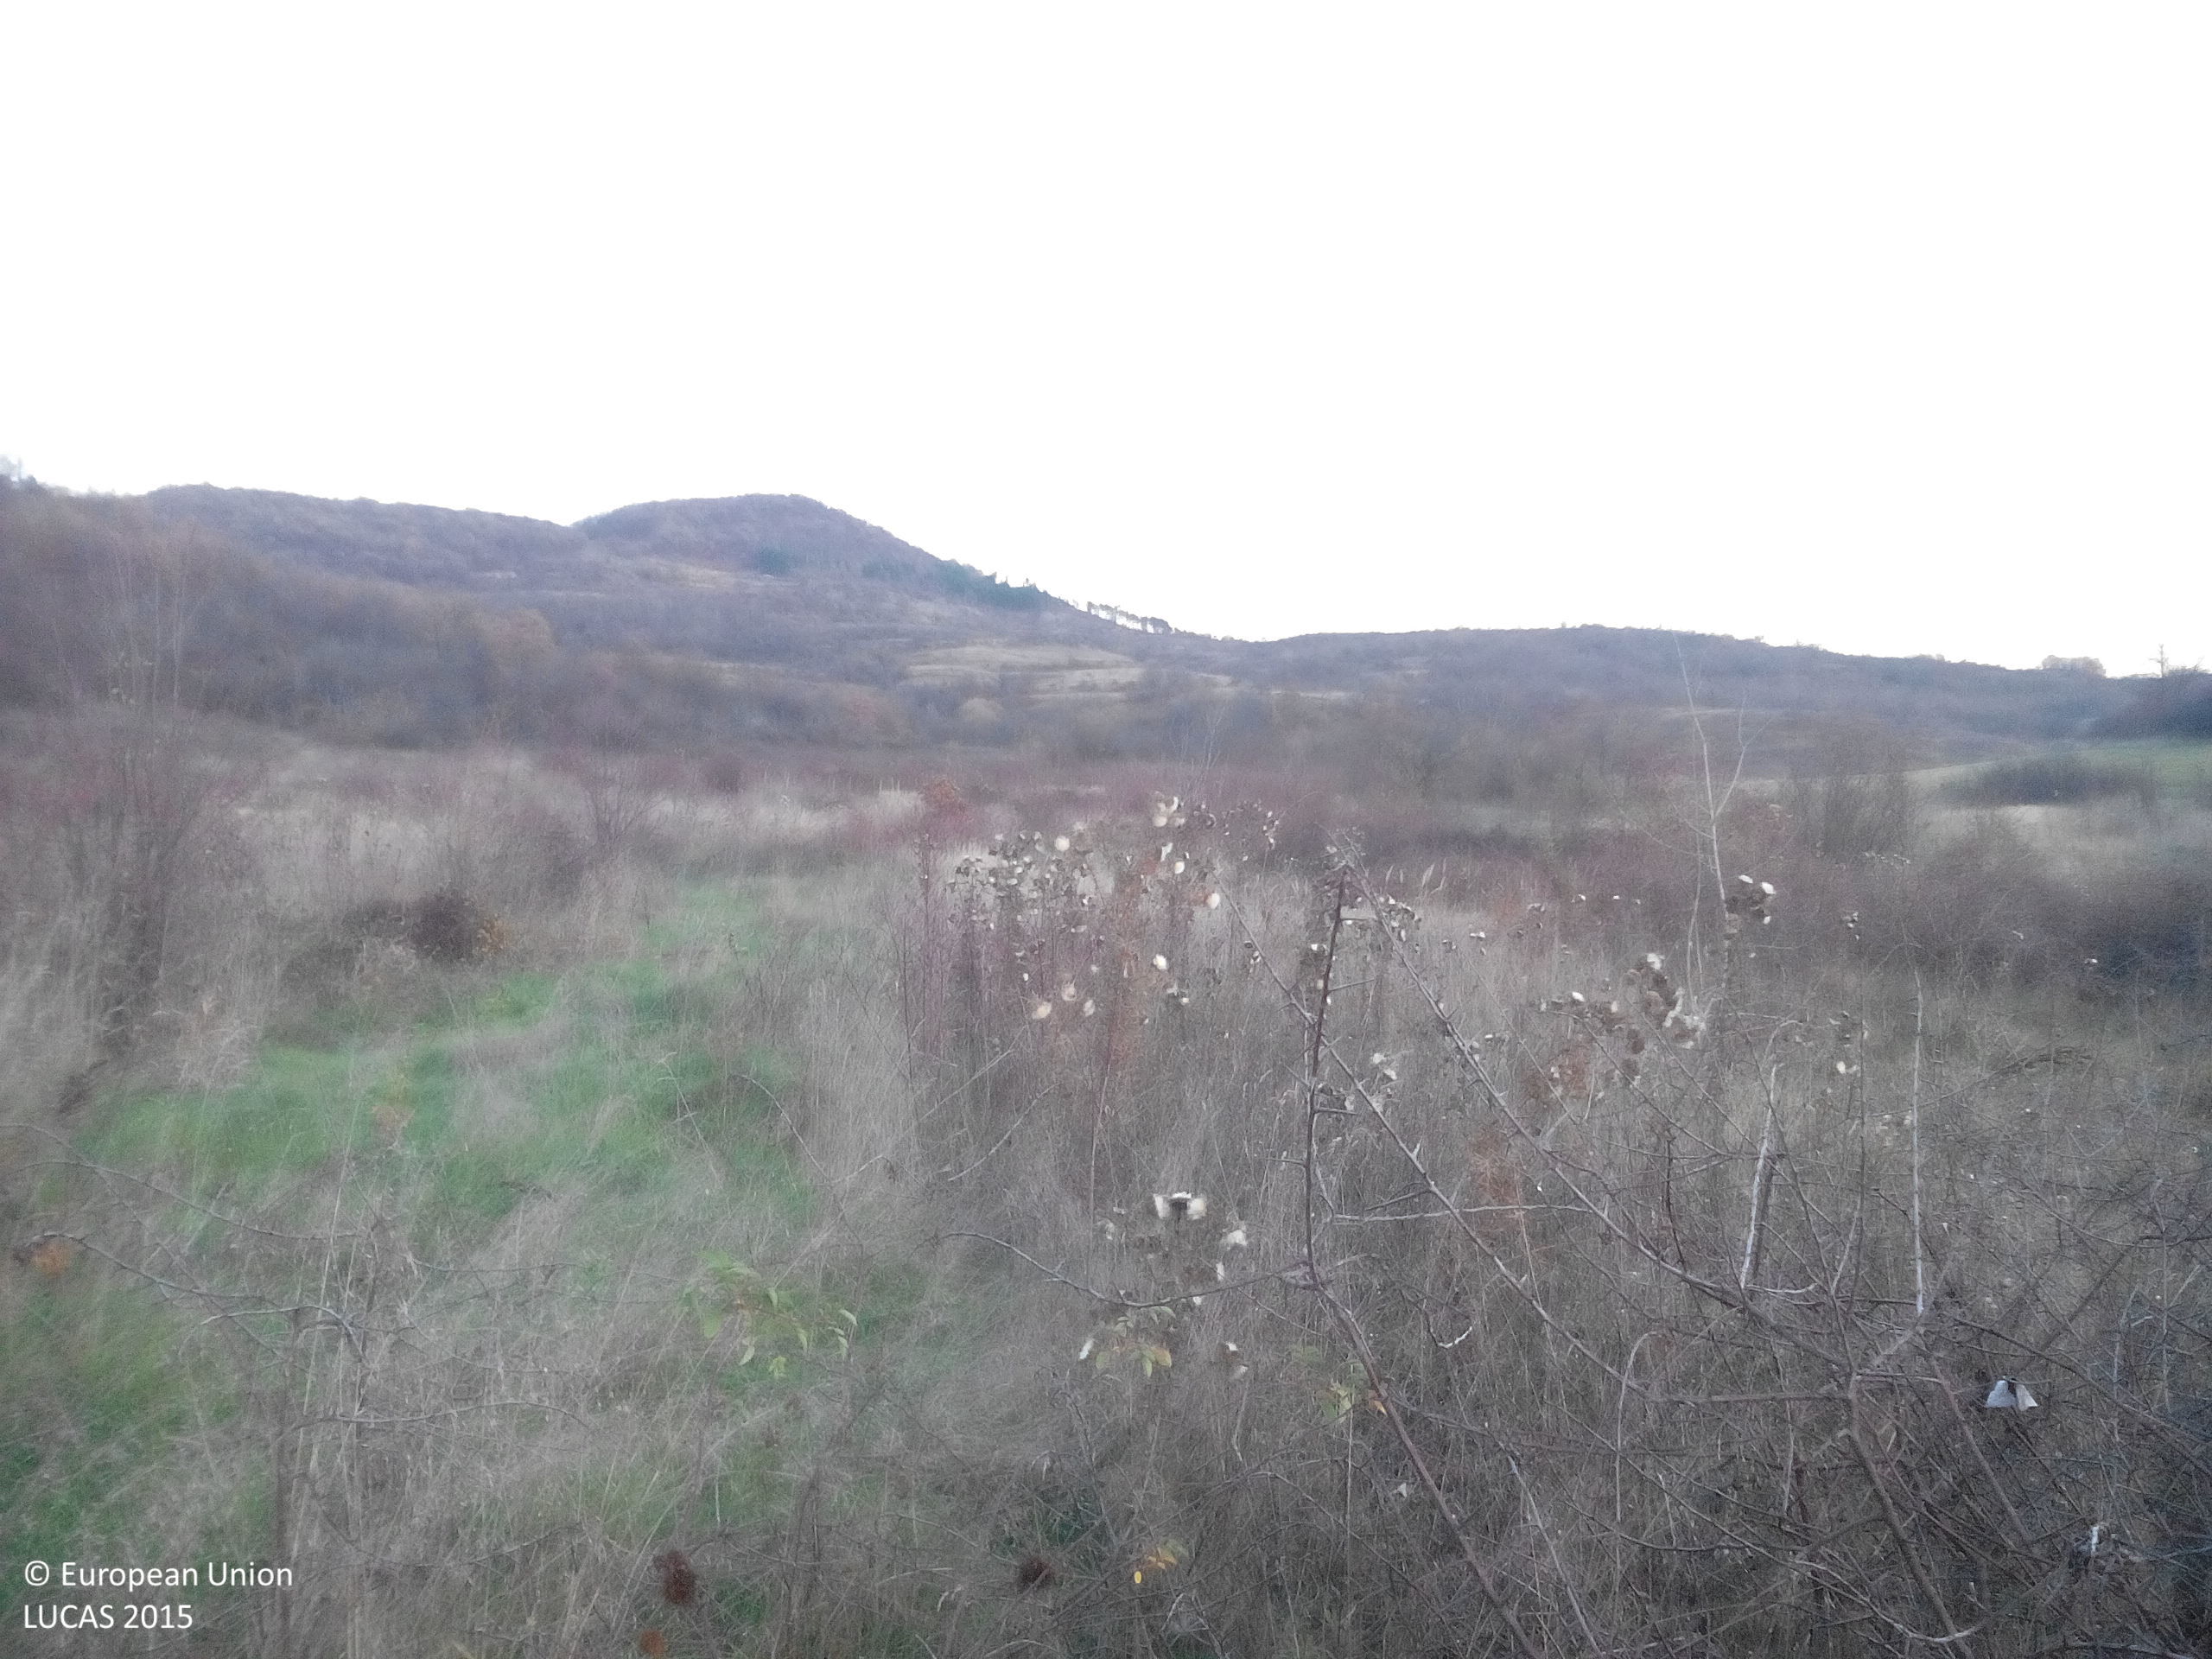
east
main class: Shrubland
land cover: Shrubland without tree cover
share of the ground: > 75 %
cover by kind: shrubs 90 %, herbaceous plants 10 %
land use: Abandoned areas
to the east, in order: Shrubland without tree cover; Tracks; Shrubland without tree cover; Fences; Spontaneously vegetated surfaces; Vineyards; Spontaneously vegetated surfaces; Shrubland without tree cover
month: November
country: BG
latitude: 43.1130
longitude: 23.7973
